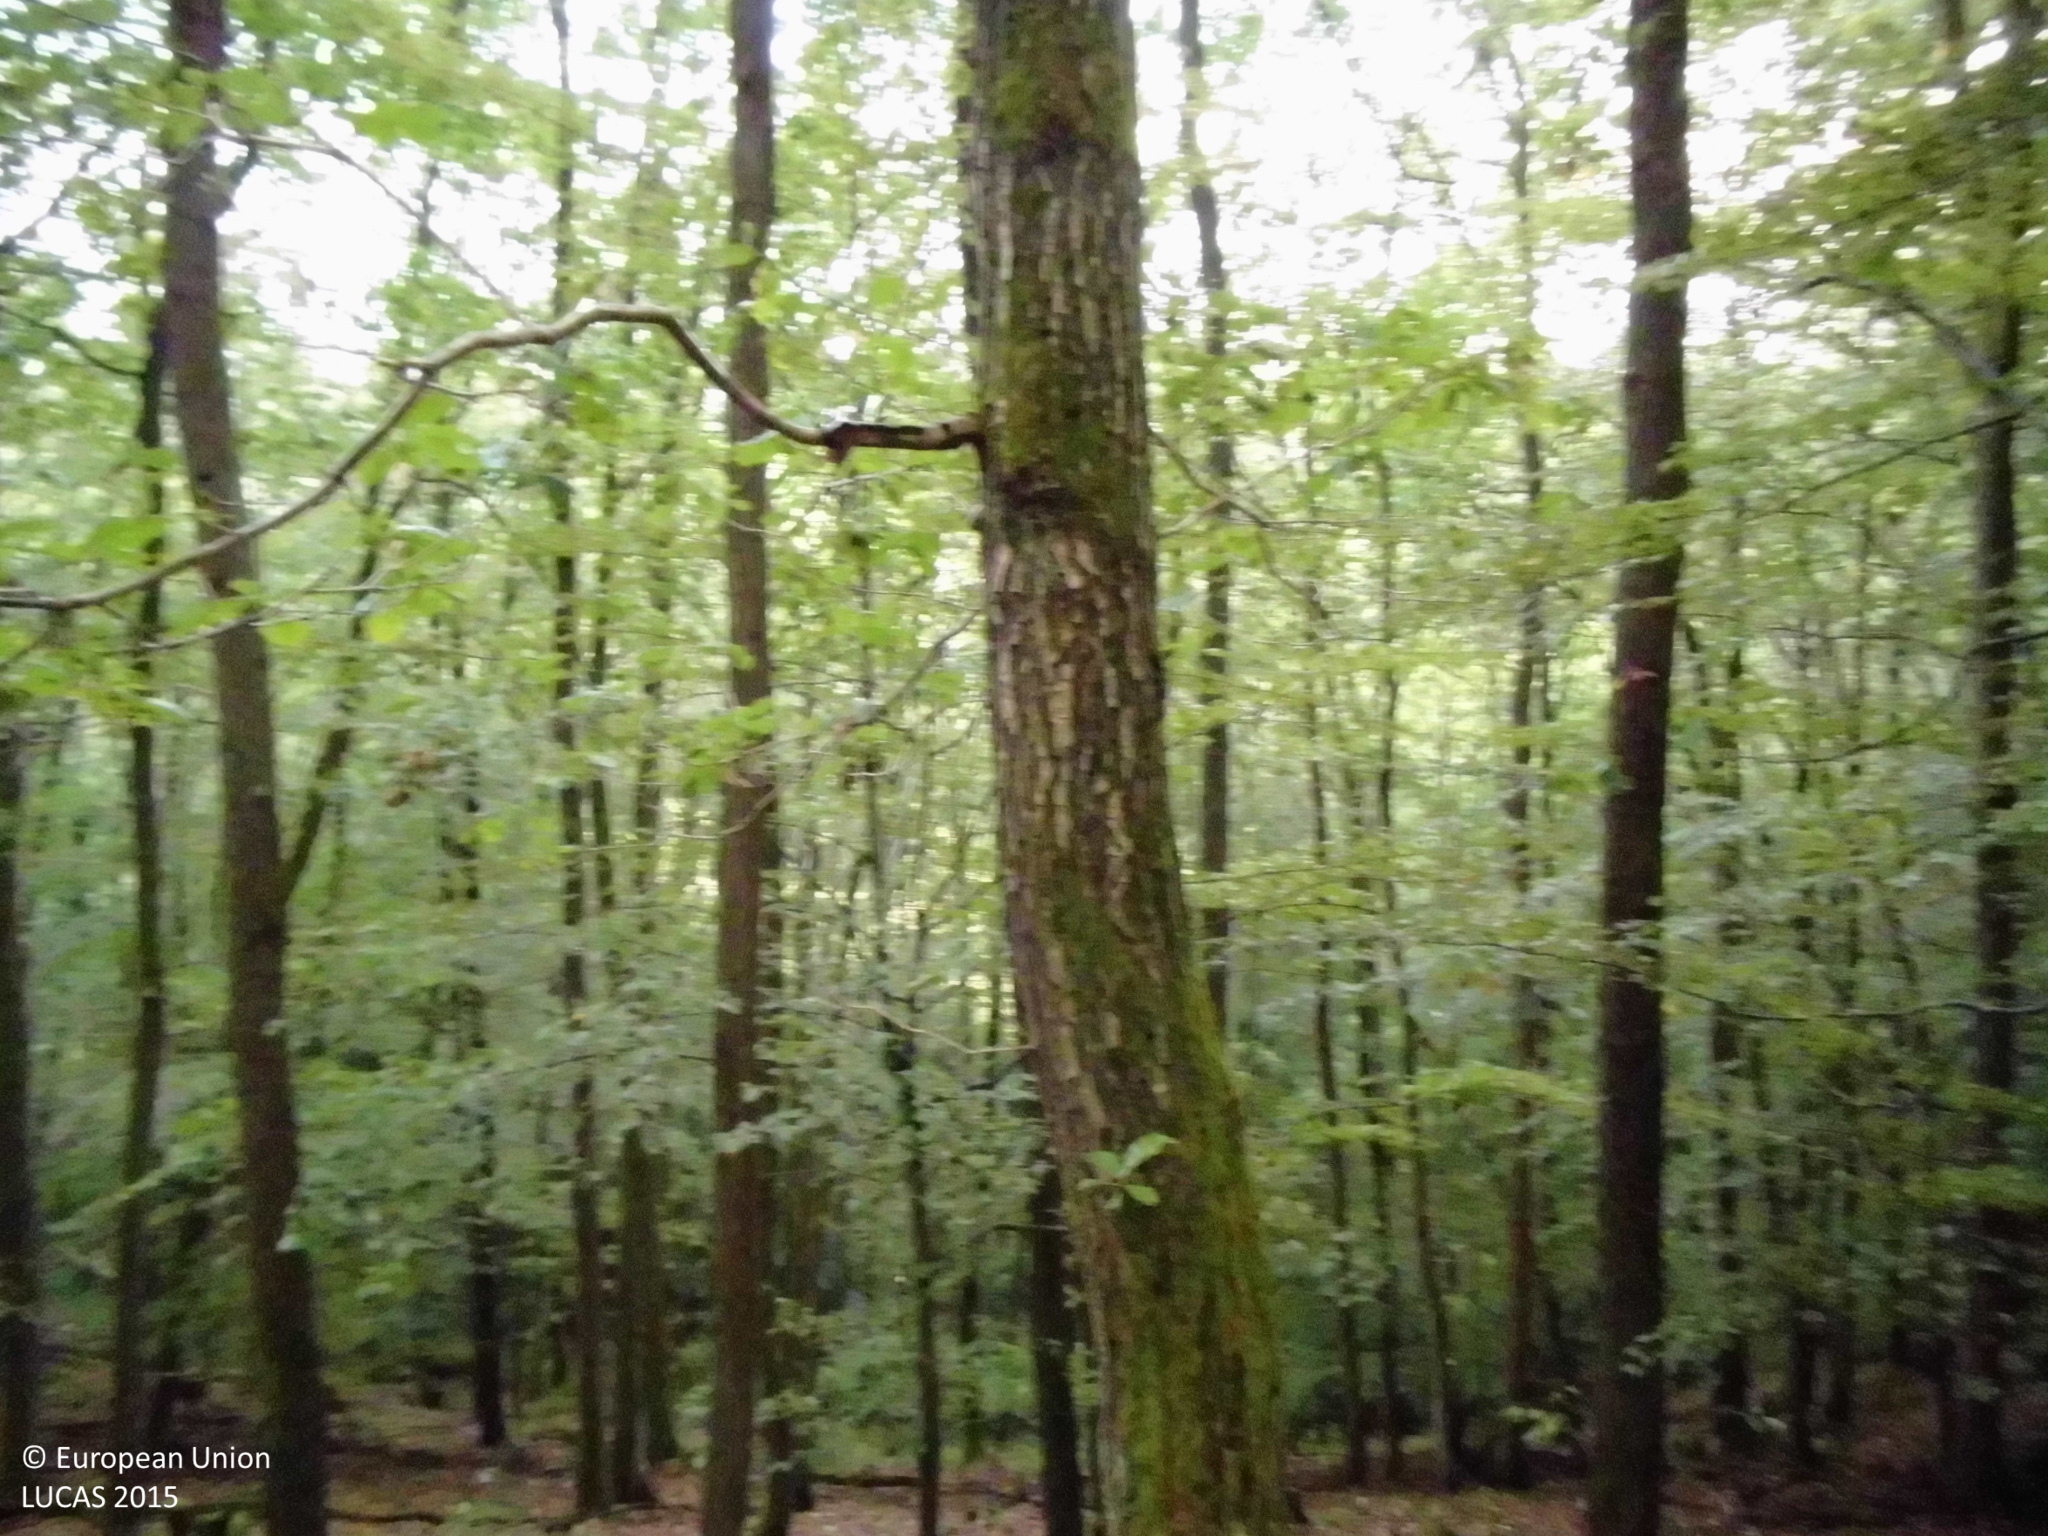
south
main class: Woodland
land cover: Broadleaved woodland
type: mesophytic deciduous forest
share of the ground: > 75 %
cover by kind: broadleaved forest trees 100 %
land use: Forestry
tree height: > 5 m
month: September
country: DE
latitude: 50.5874
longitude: 7.4437
